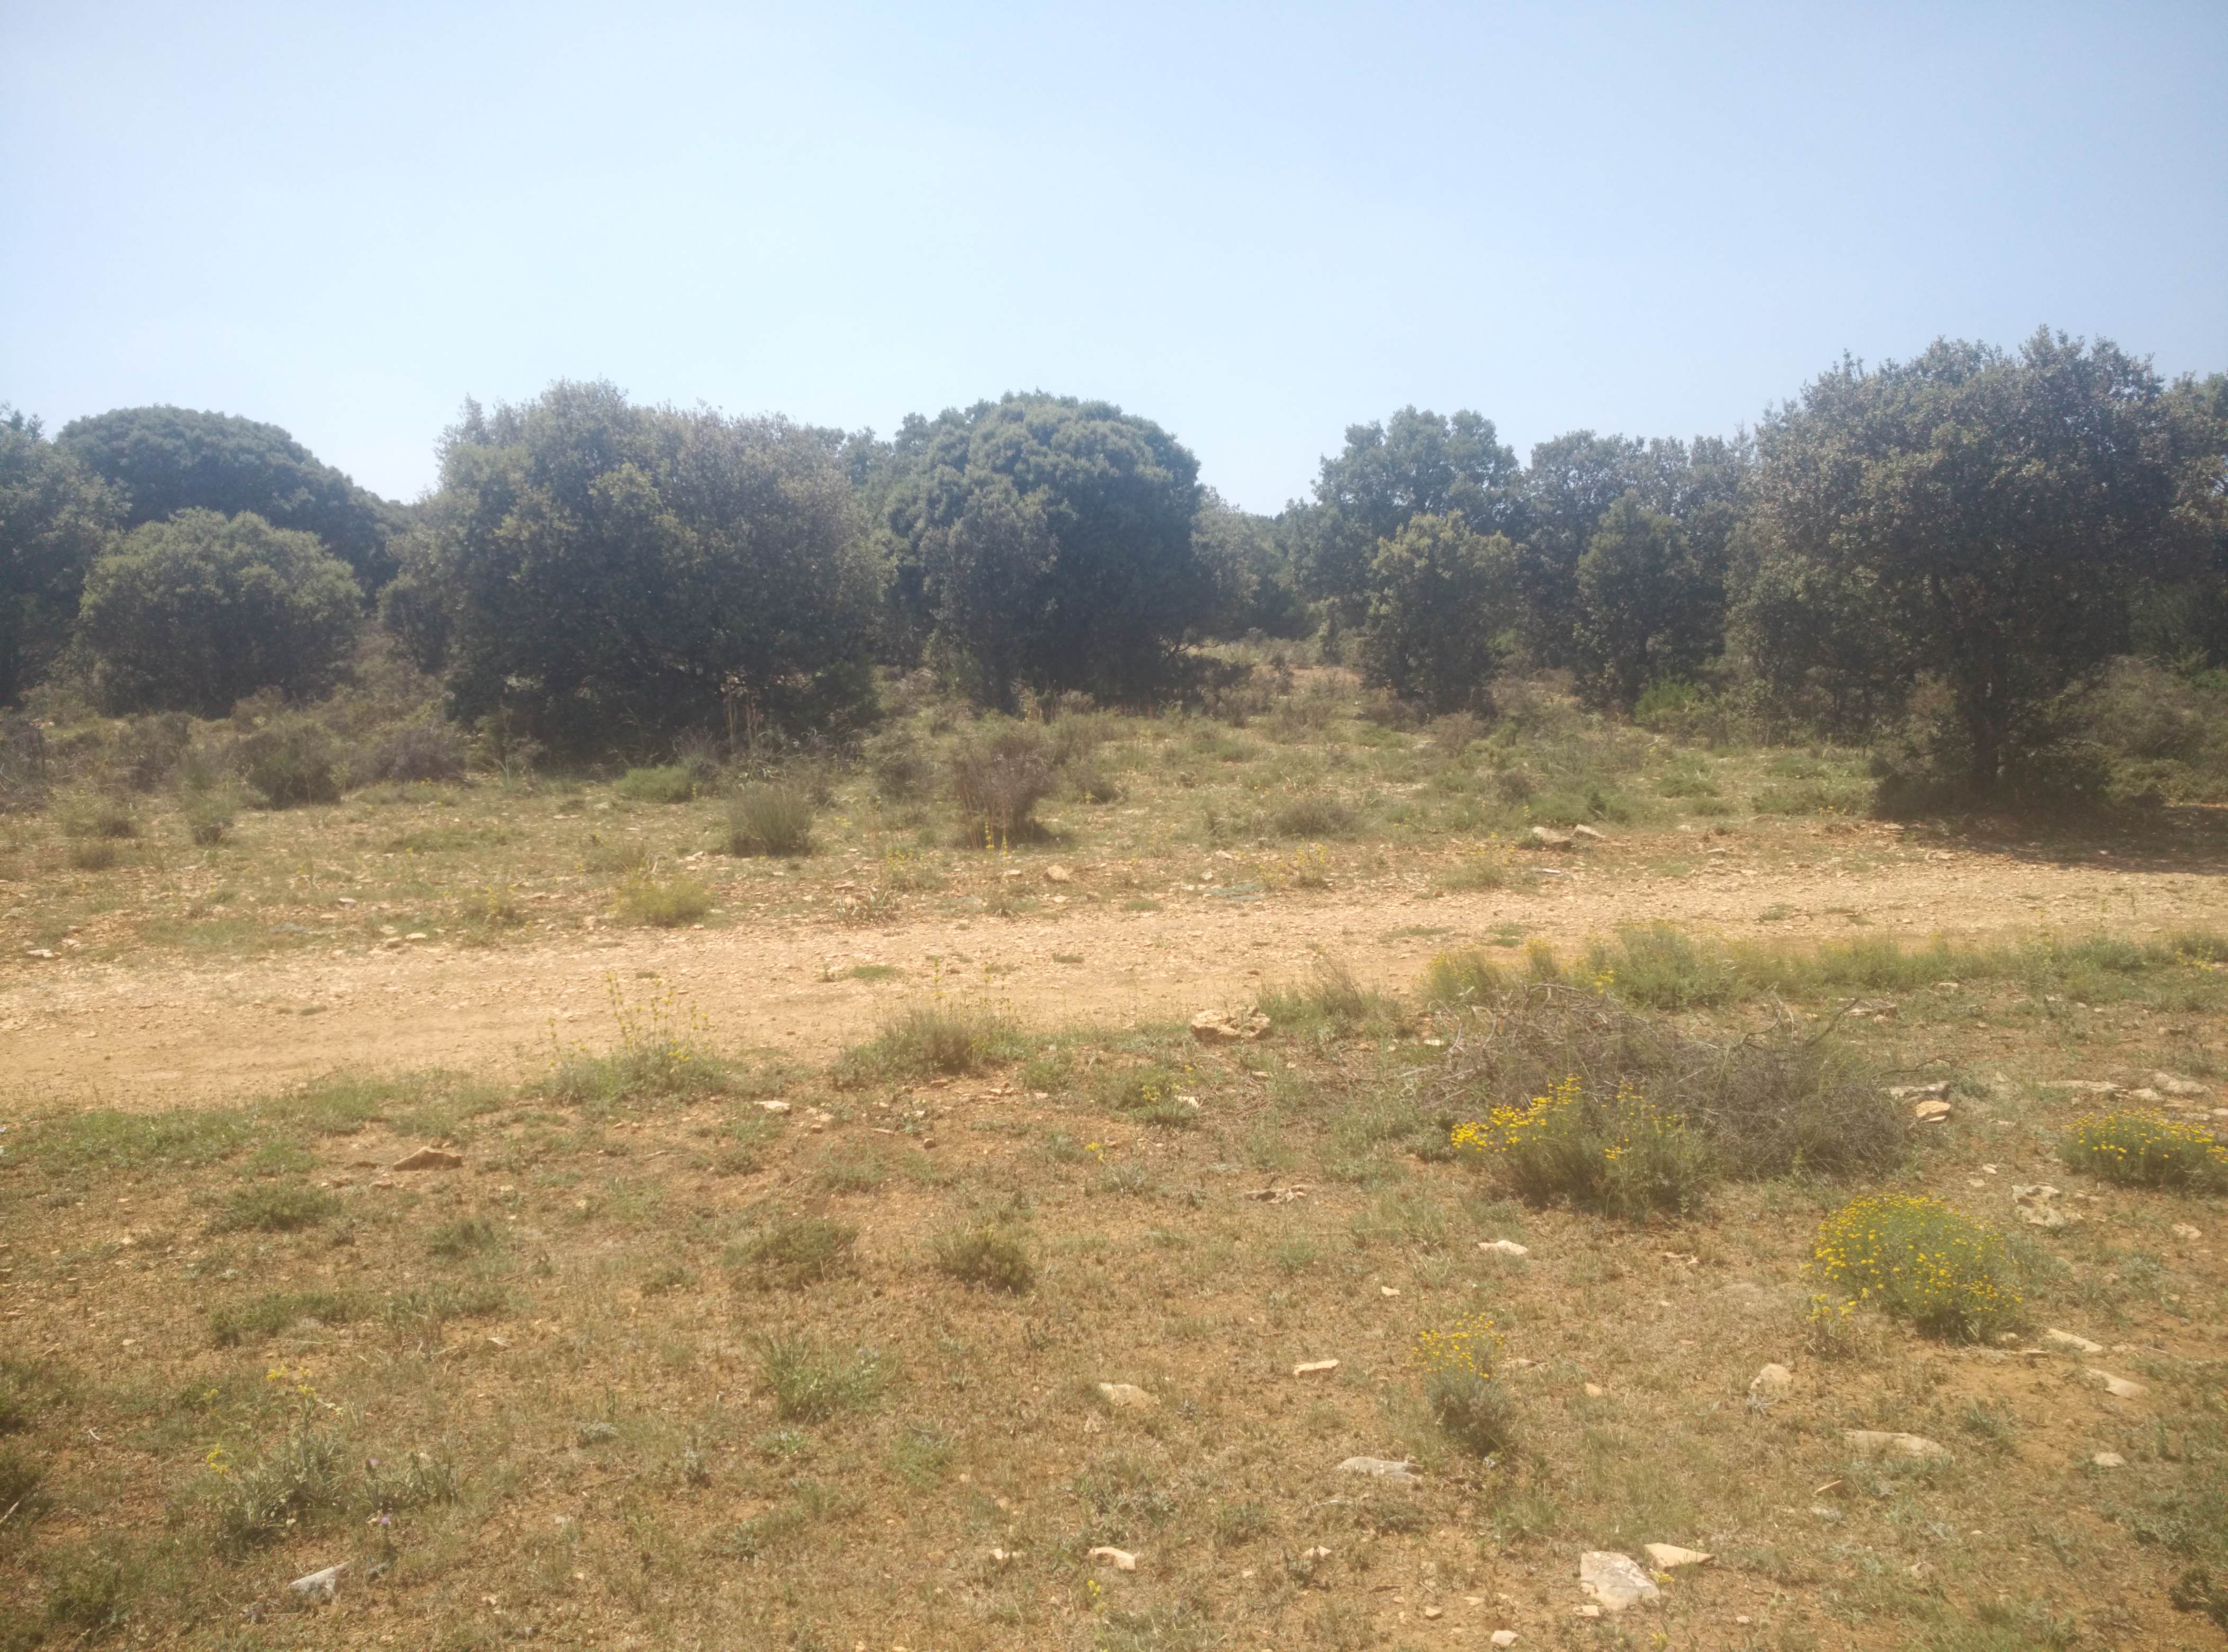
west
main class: Shrubland
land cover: Shrubland without tree cover
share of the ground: 25 - 50 %
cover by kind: unconsolidated bare surface 55 %, shrubs 30 %, herbaceous plants 15 %
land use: Agriculture (excluding fallow land and kitchen gardens)
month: June
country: ES
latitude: 40.7870
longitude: -1.8599
